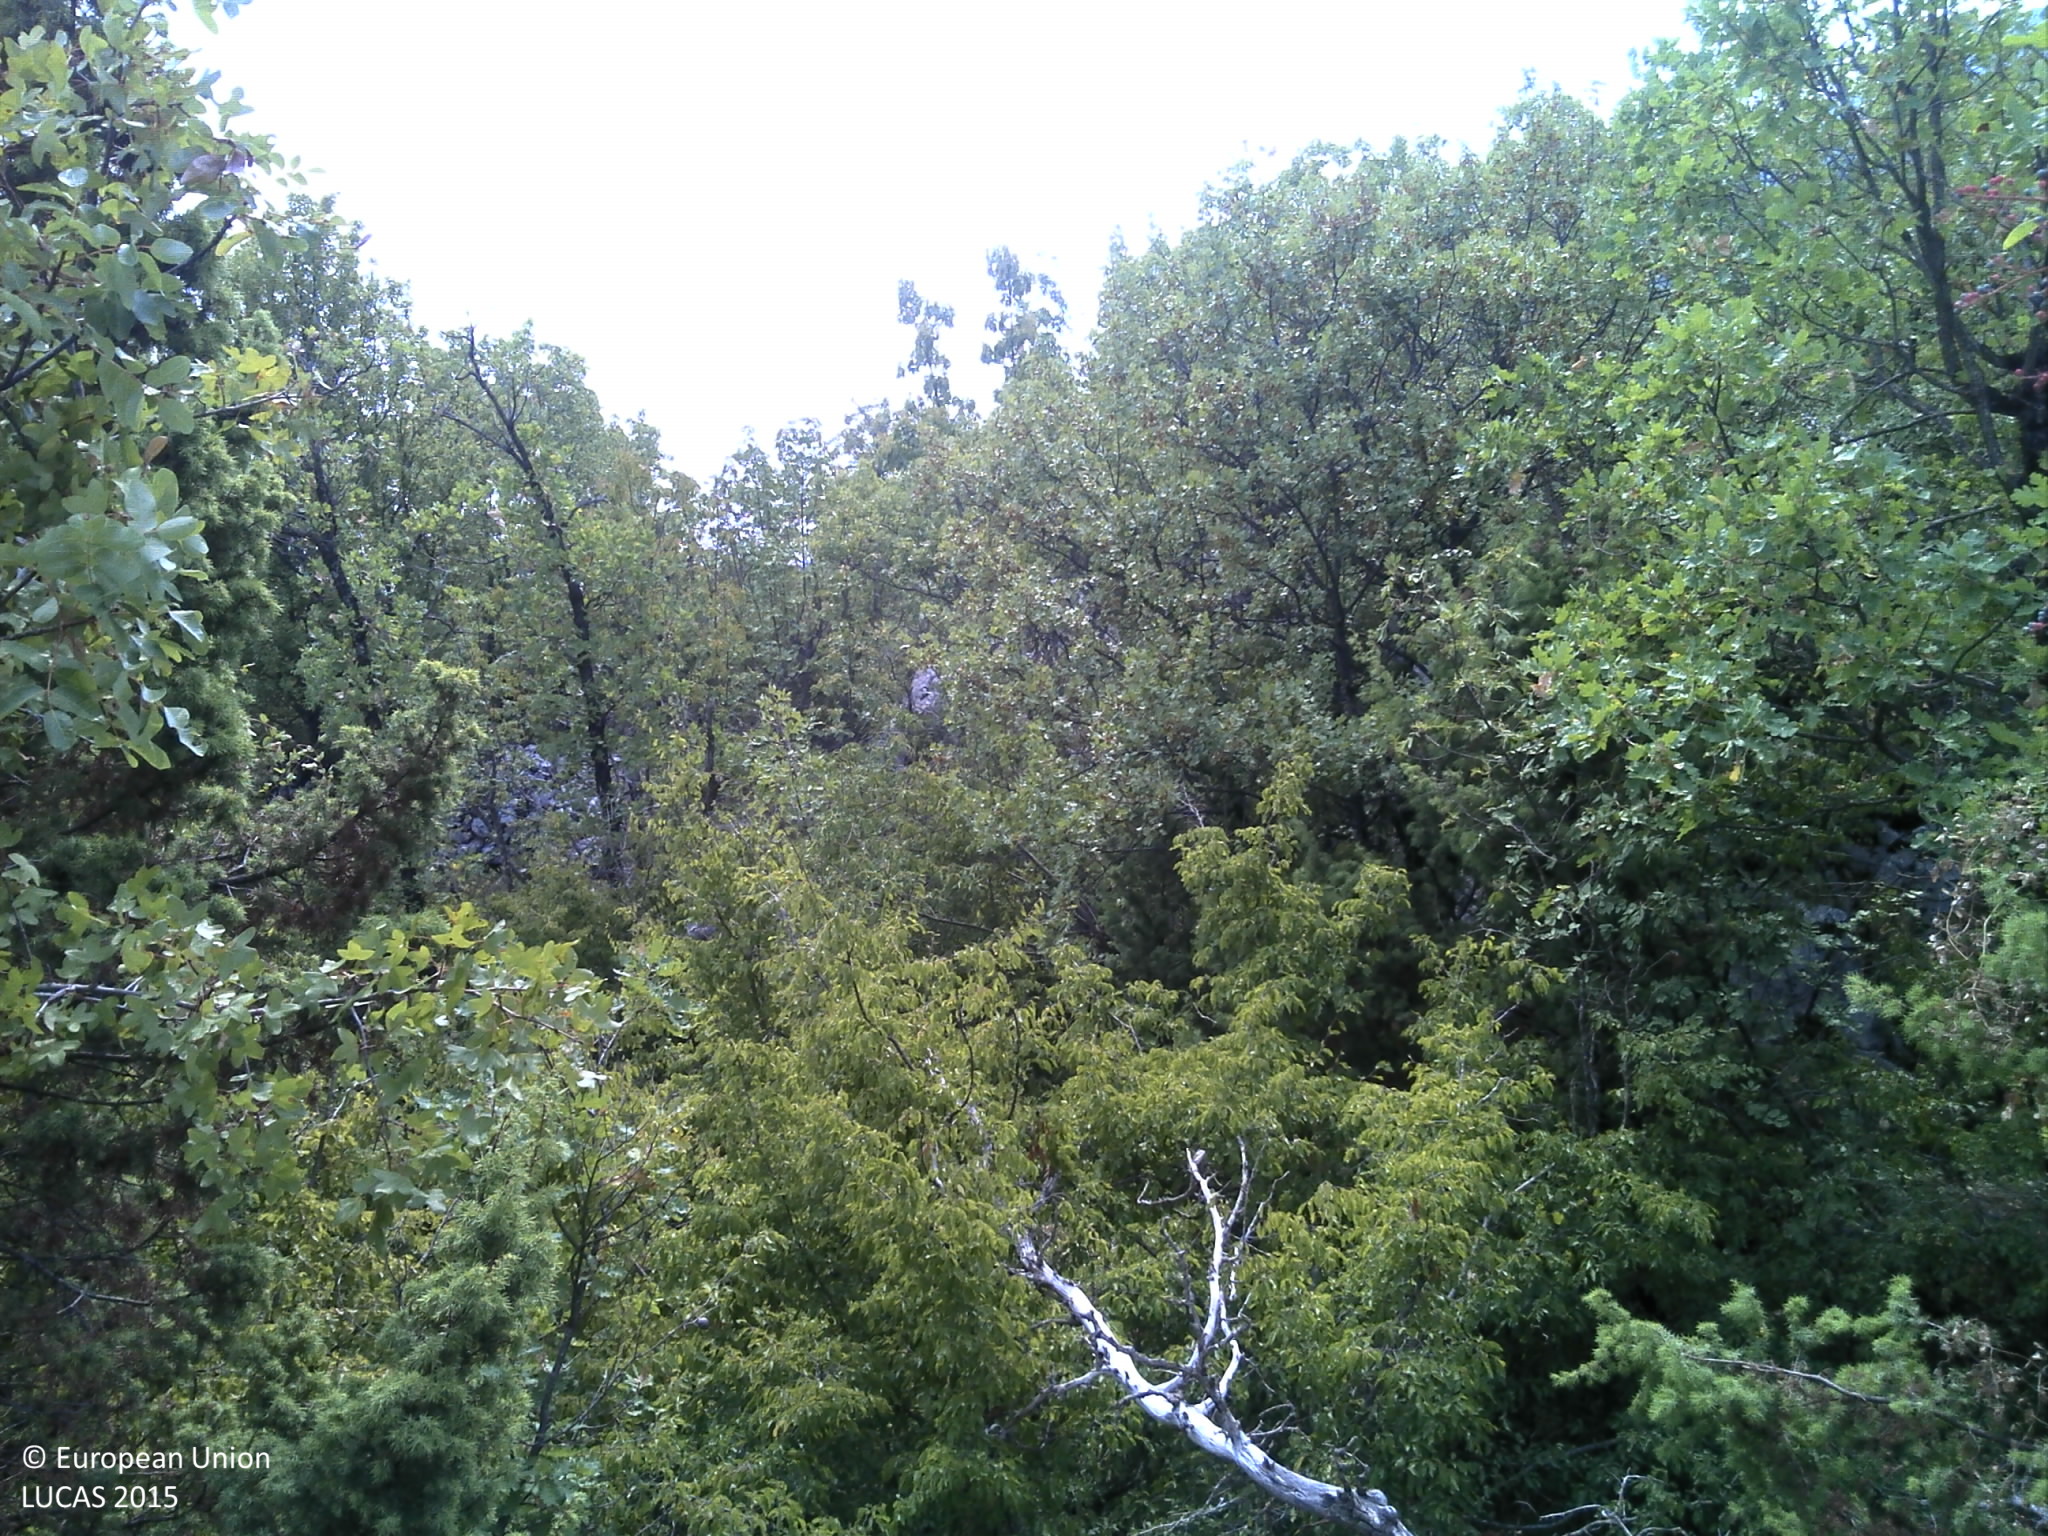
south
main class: Shrubland
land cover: Shrubland with sparse tree cover
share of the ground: 50 - 75 %
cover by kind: shrubs 70 %, consolidated bare surface 10 %, unconsolidated bare surface 10 %, broadleaved forest trees 5 %, herbaceous plants 5 %
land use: Semi-natural and natural areas not in use
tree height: < 5 m
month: August
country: HR
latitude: 43.3068
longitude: 17.1538
